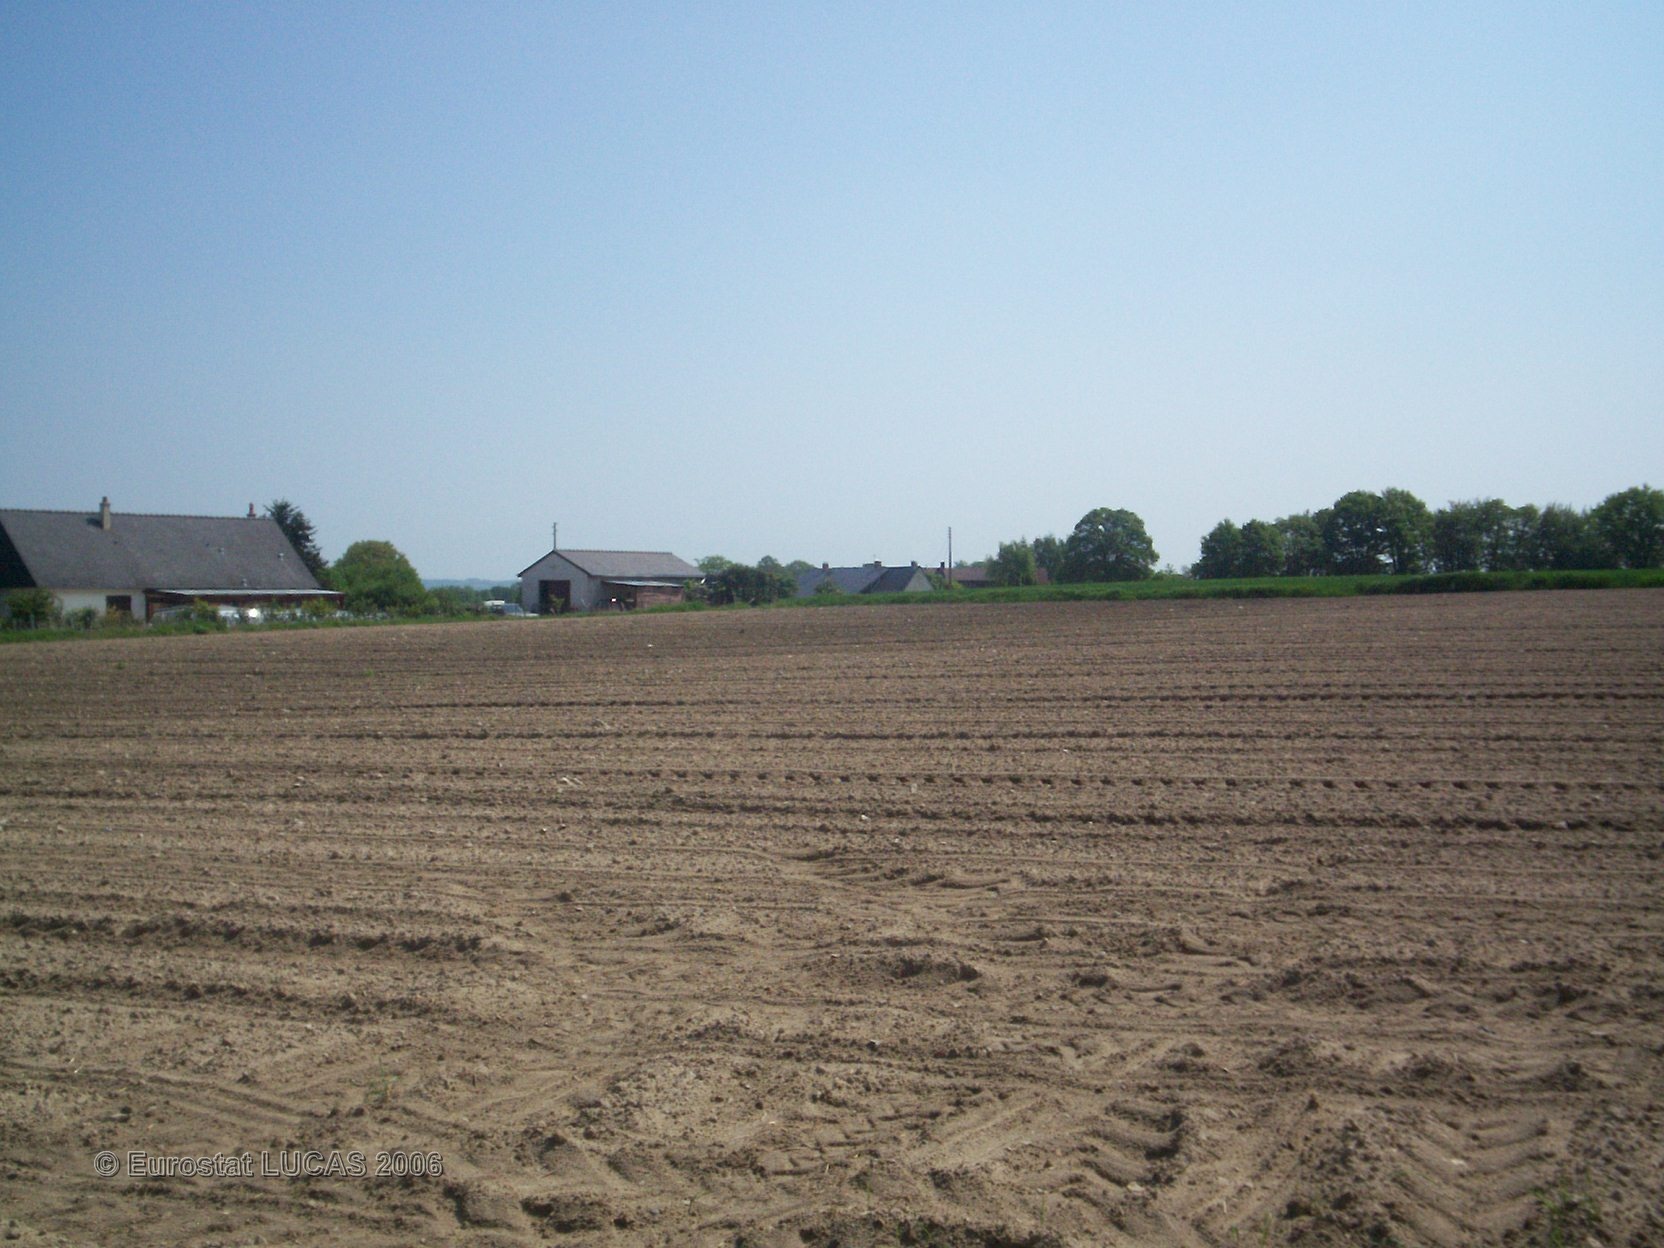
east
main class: Cropland
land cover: Maize
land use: Agriculture (excluding fallow land and kitchen gardens)
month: May
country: FR
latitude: 47.7827
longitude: 0.1645
